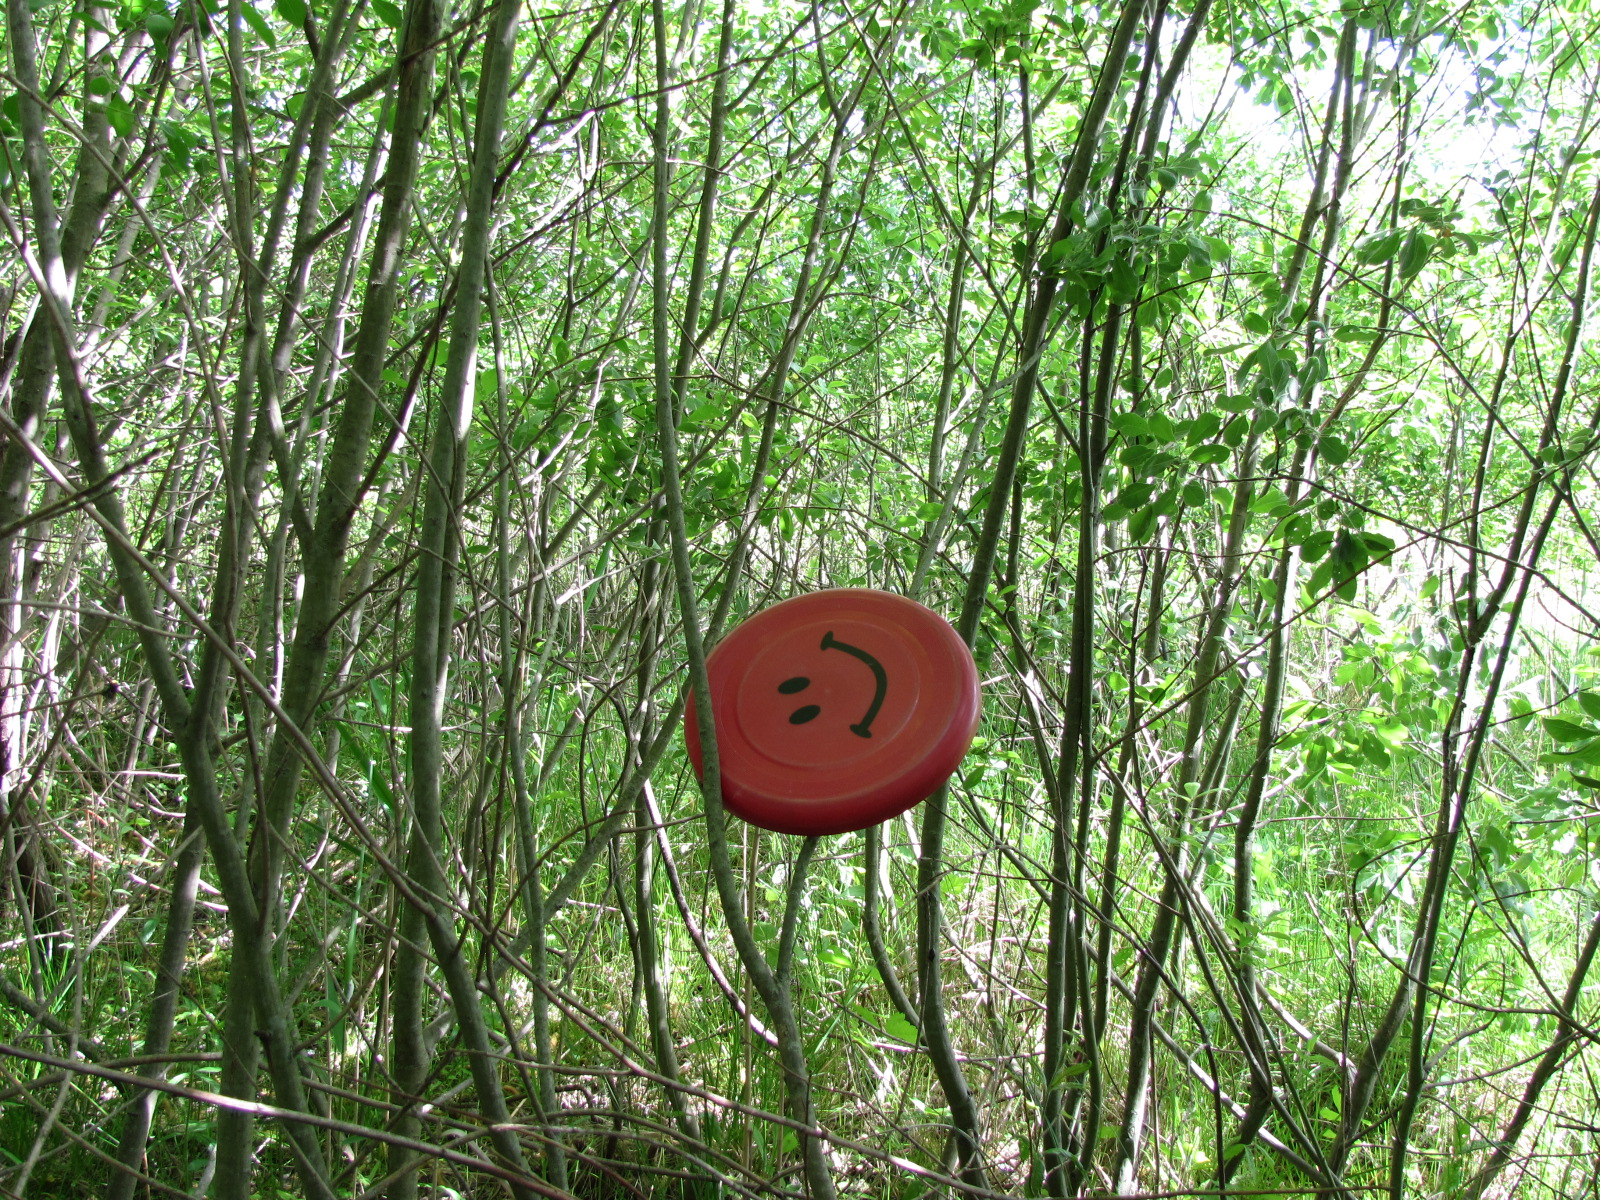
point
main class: Shrubland
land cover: Shrubland without tree cover
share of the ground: > 75 %
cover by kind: shrubs 100 %
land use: Semi-natural and natural areas not in use
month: June
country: LV
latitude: 56.2788
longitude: 24.1243
